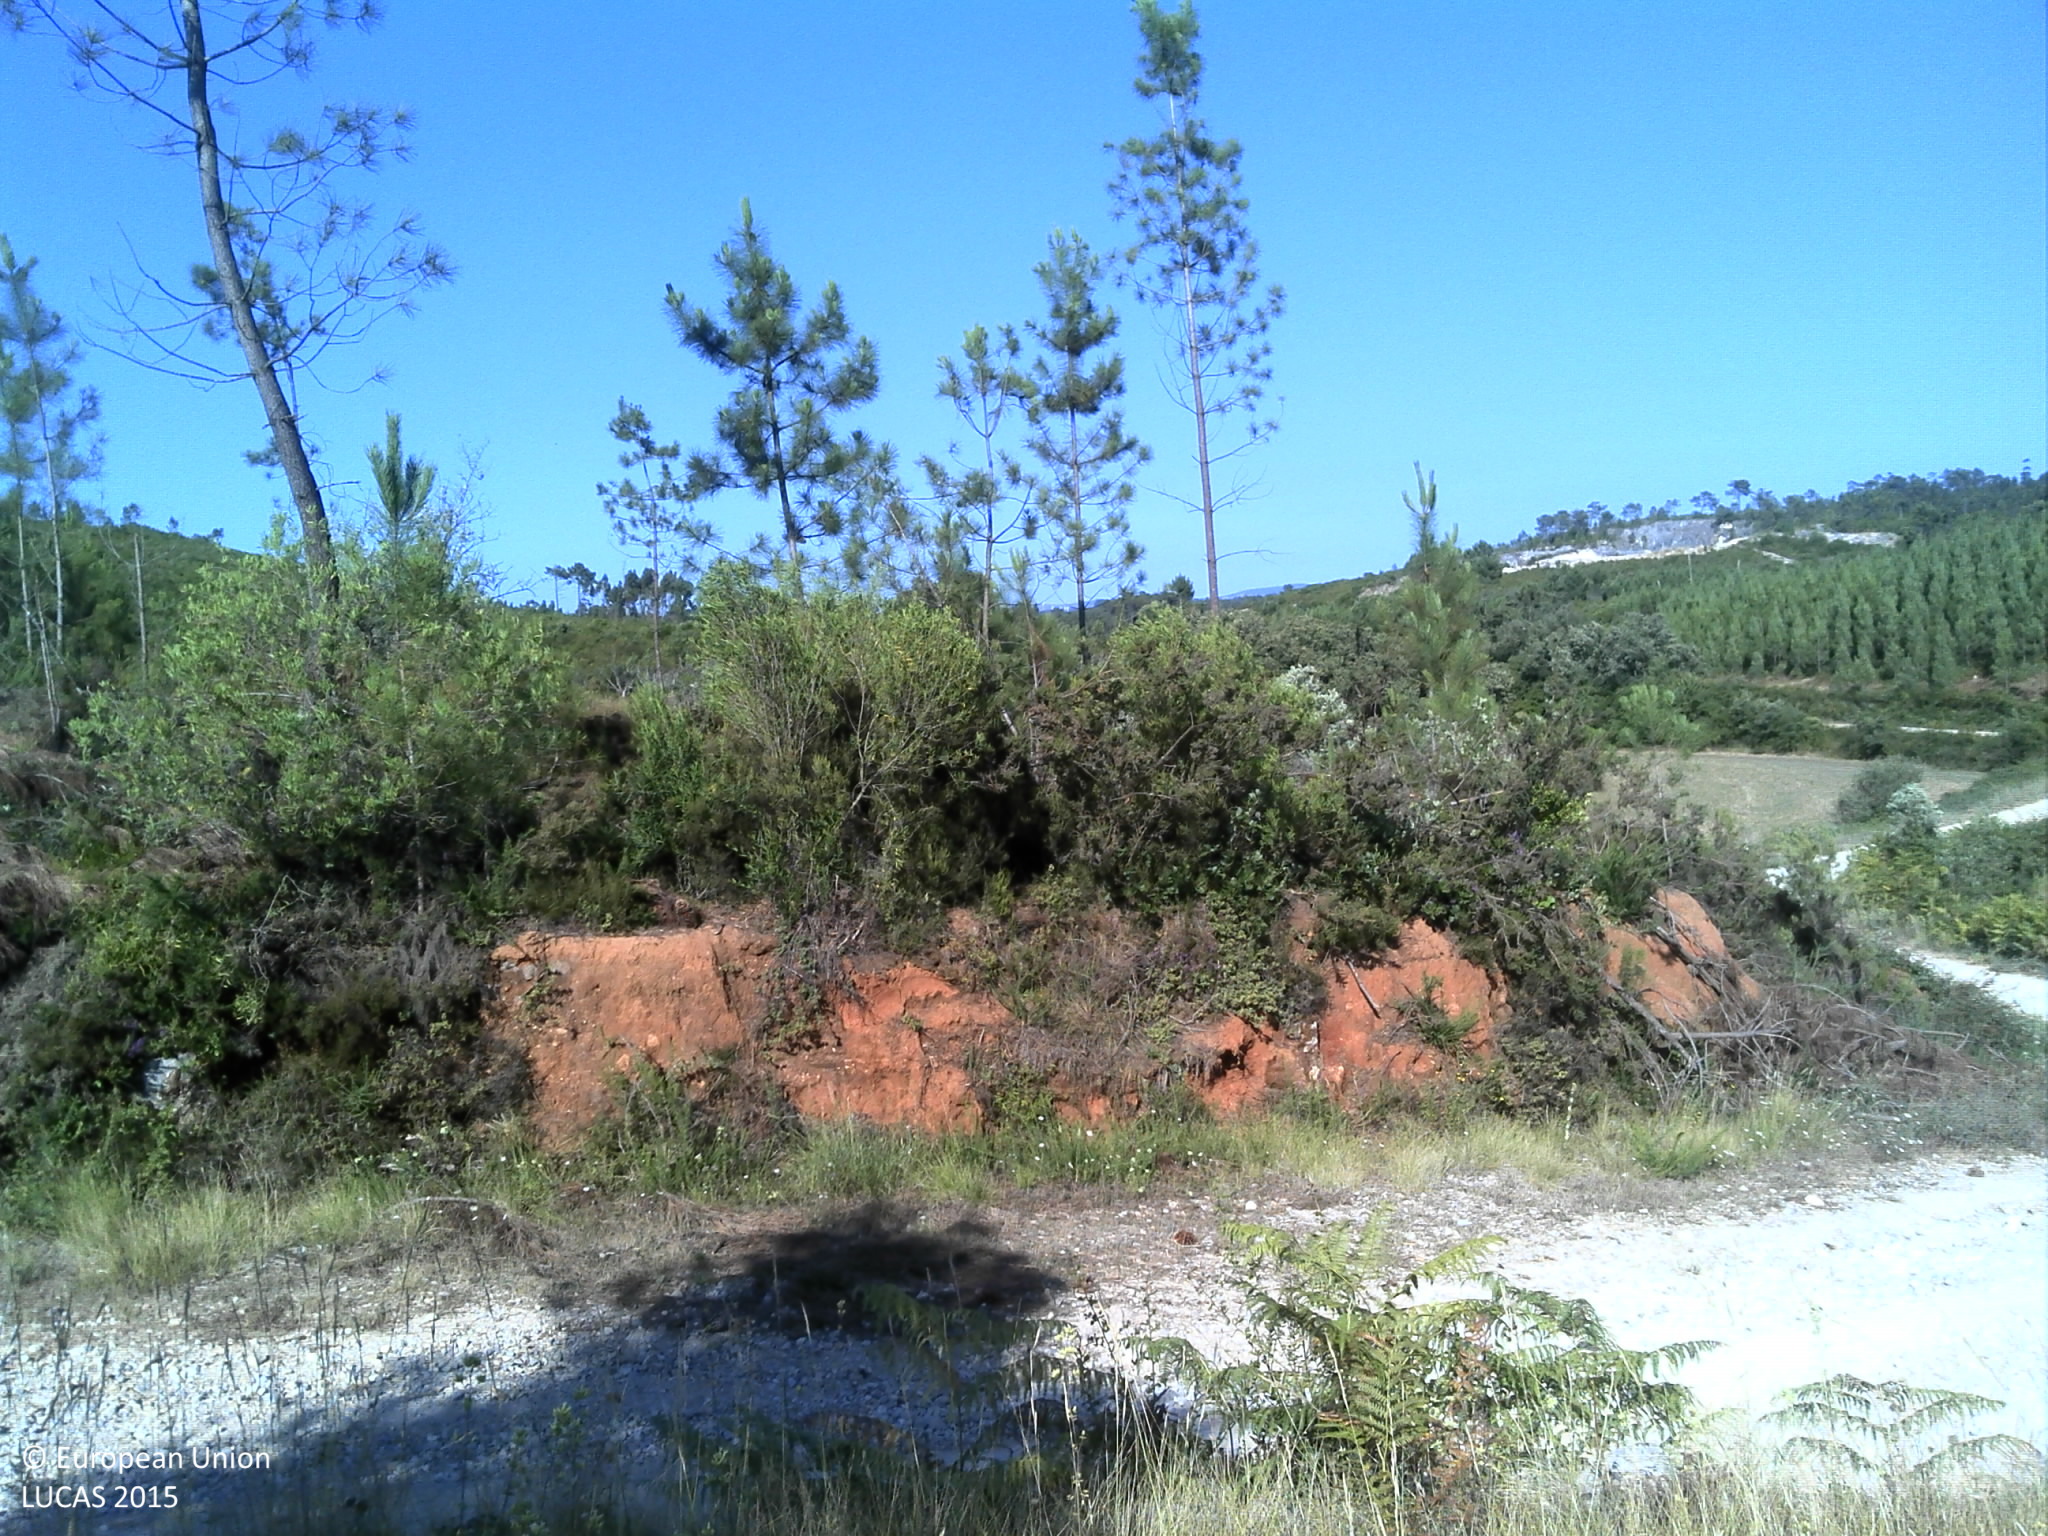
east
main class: Cropland
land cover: Olive groves
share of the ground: 10 - 25 %
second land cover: Grassland without tree/shrub cover
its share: > 75 %
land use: Agriculture (excluding fallow land and kitchen gardens)
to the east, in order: Olive groves; Grassland without tree/shrub cover; Dry stone walls; Tracks; Grass margins; Shrubland with sparse tree cover; Other bare soil; Tracks; Olive groves; Oats; Broadleaved woodland; Oats
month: July
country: PT
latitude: 39.9840
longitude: -8.5264
